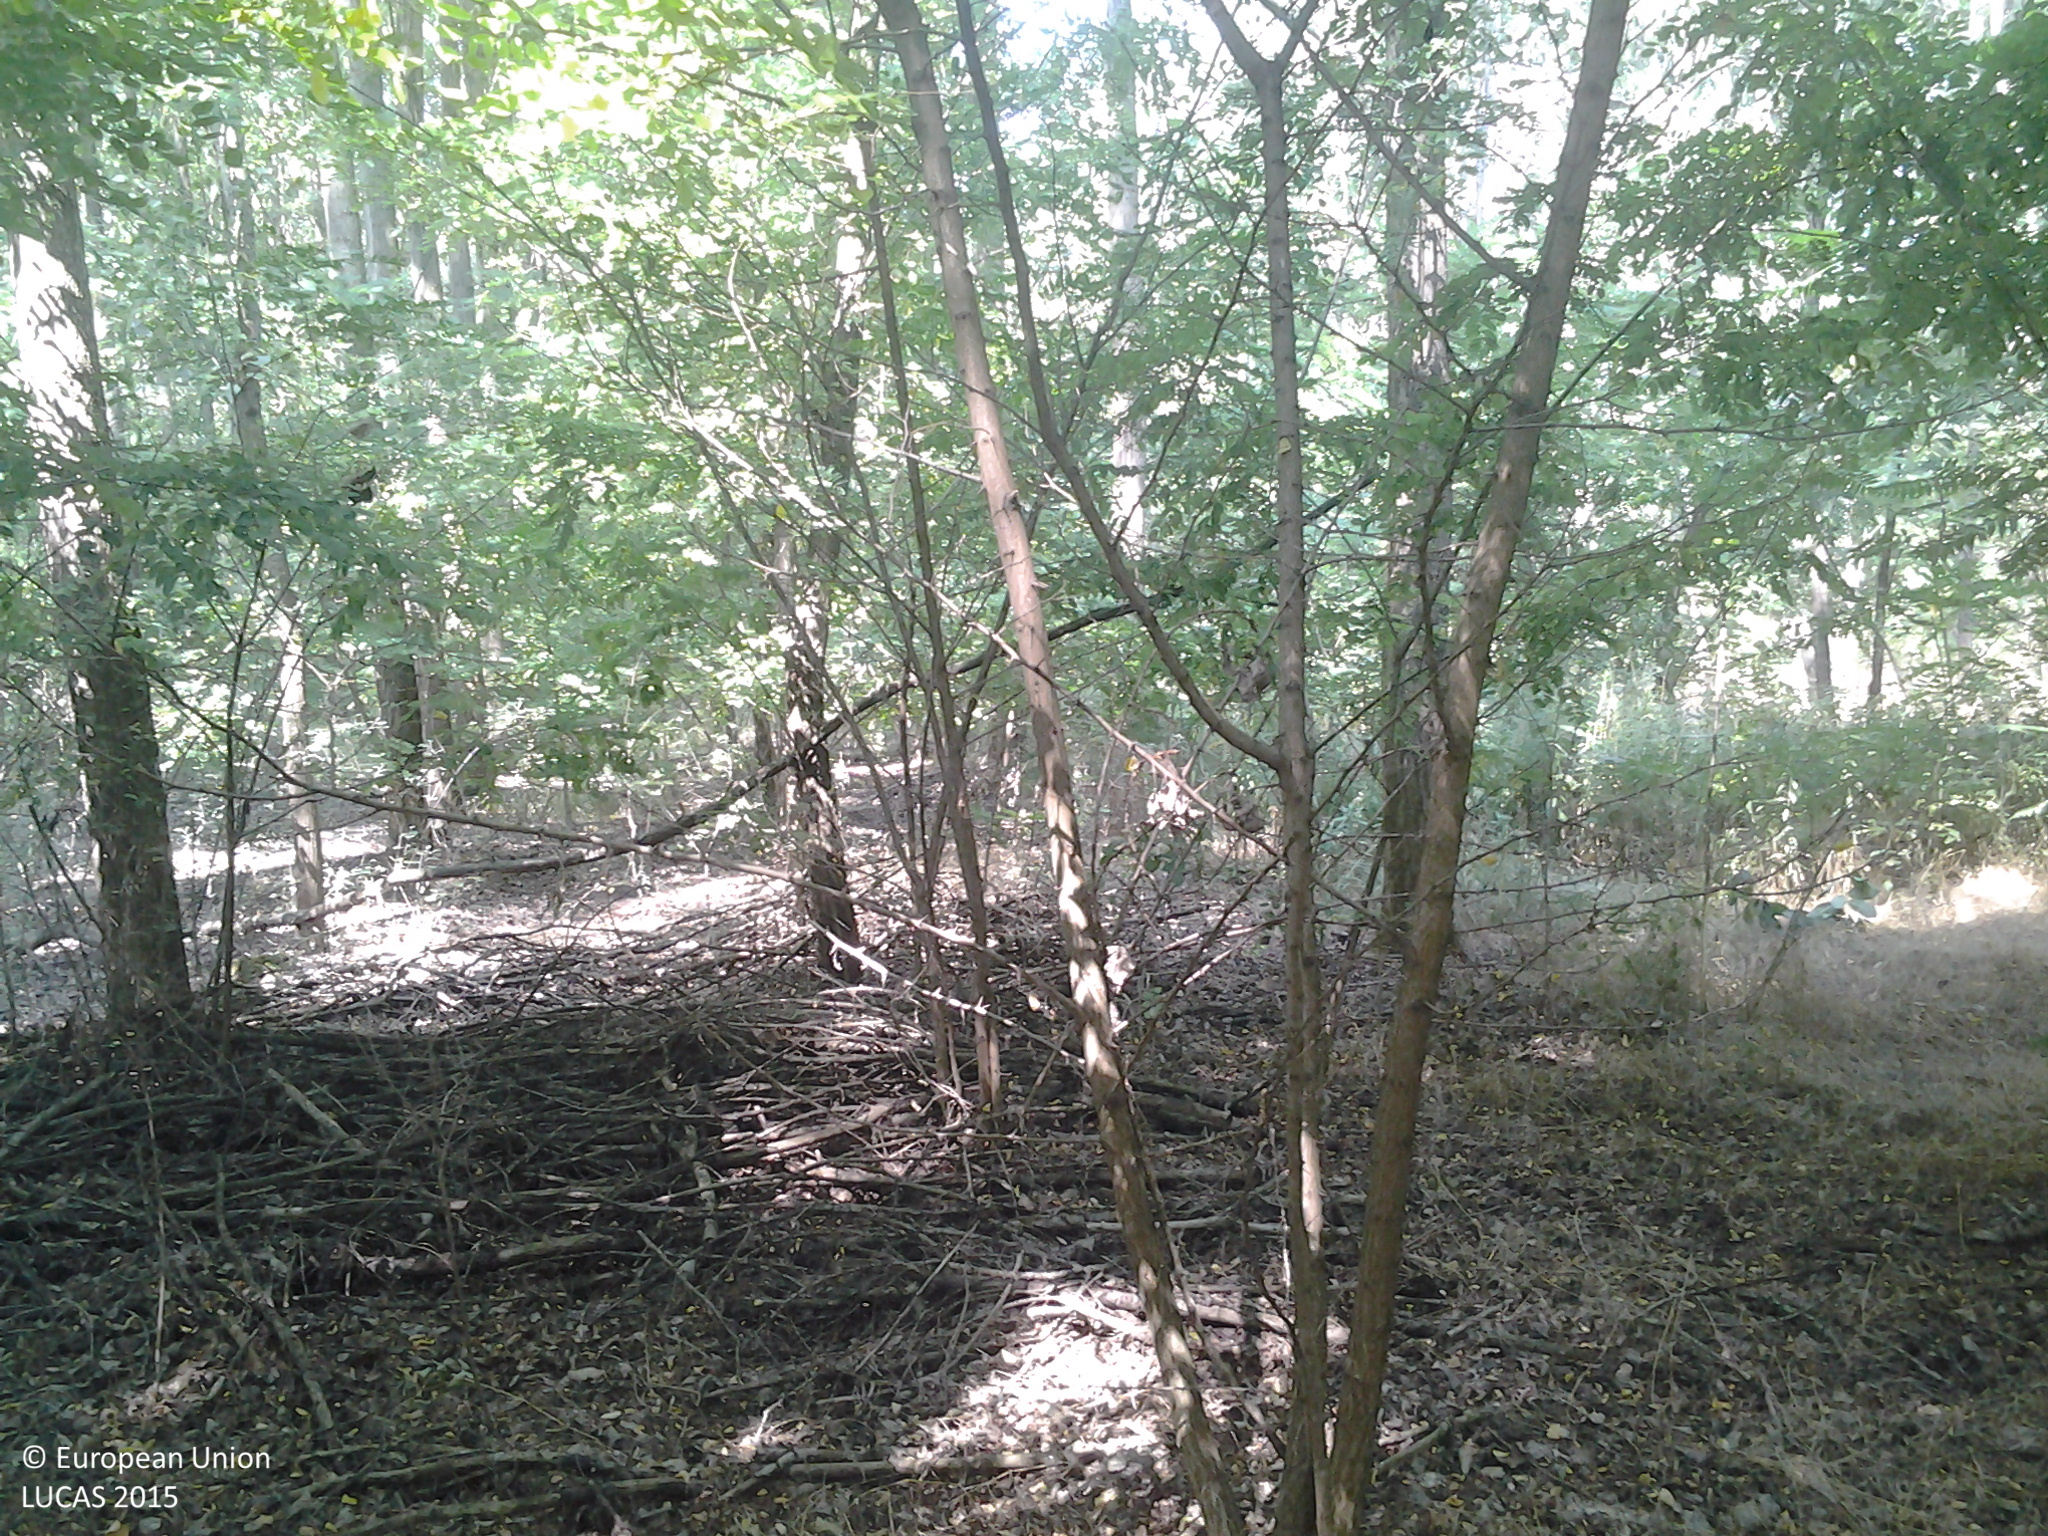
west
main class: Woodland
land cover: Broadleaved woodland
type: exotic forest
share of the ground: 50 - 75 %
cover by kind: broadleaved forest trees 70 %, herbaceous plants 30 %
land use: Forestry
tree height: > 5 m
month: July
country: HU
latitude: 46.8767
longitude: 19.0030
